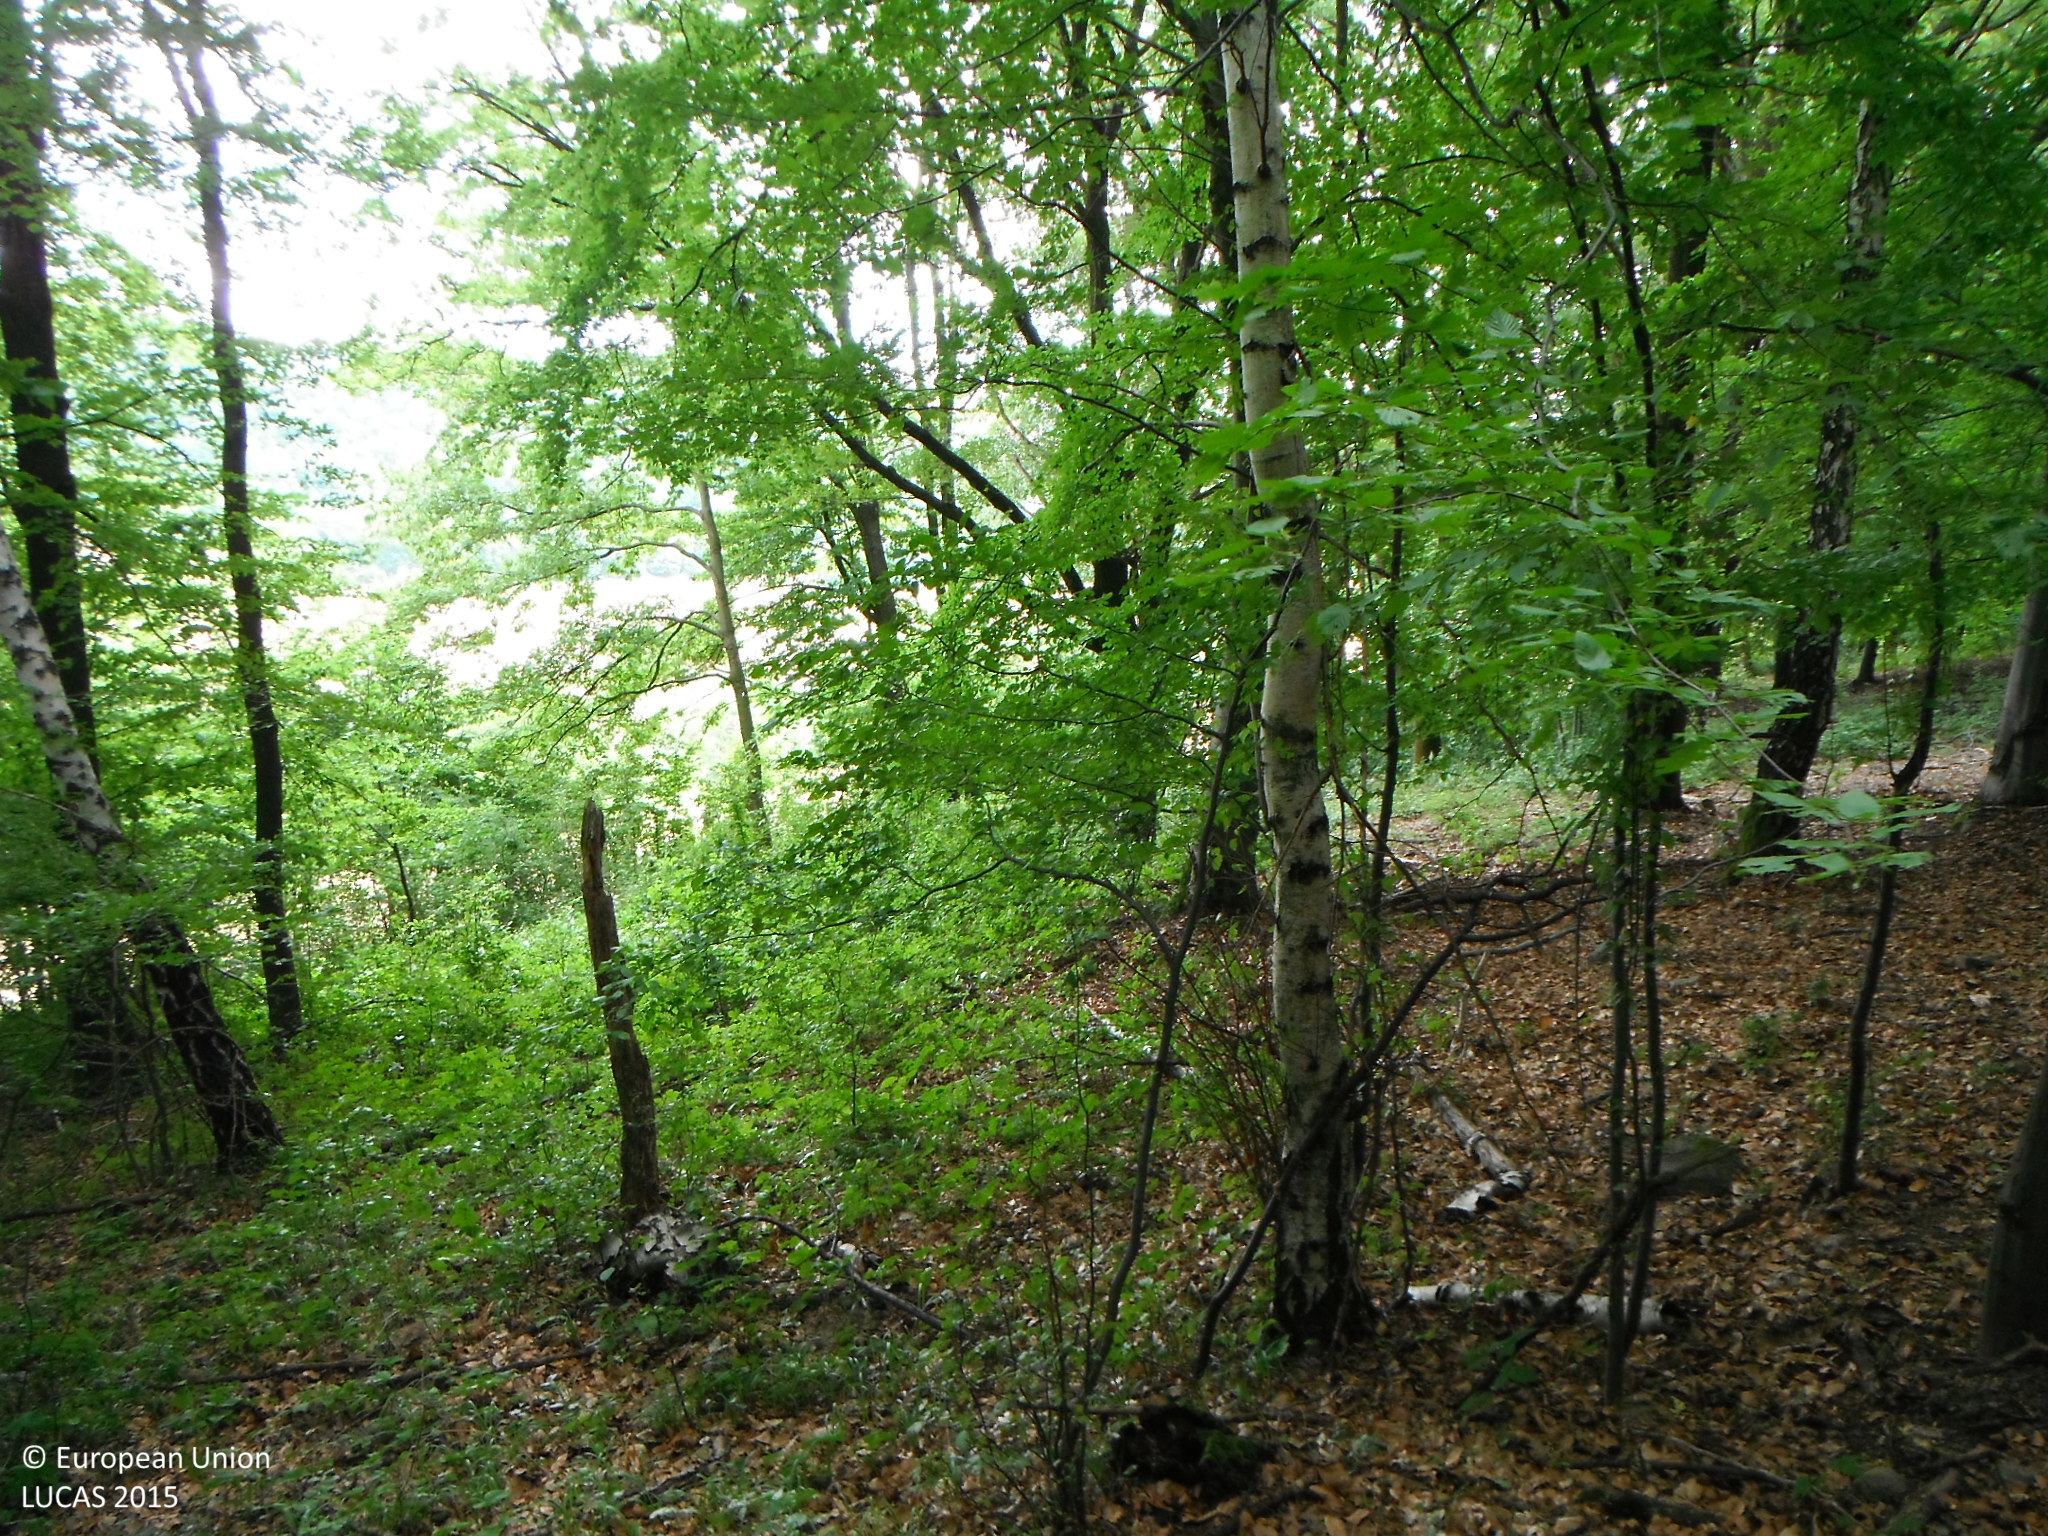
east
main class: Woodland
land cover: Broadleaved woodland
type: mesophytic deciduous forest
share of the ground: > 75 %
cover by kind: broadleaved forest trees 100 %
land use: Forestry
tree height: > 5 m
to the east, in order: Broadleaved woodland; Fences; Grassland without tree/shrub cover; Shrubland with sparse tree cover; Rivers and streams; Shrubland with sparse tree cover; Grass margins; Fences; Grassland without tree/shrub cover
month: July
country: SK
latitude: 48.3307
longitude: 18.9358
